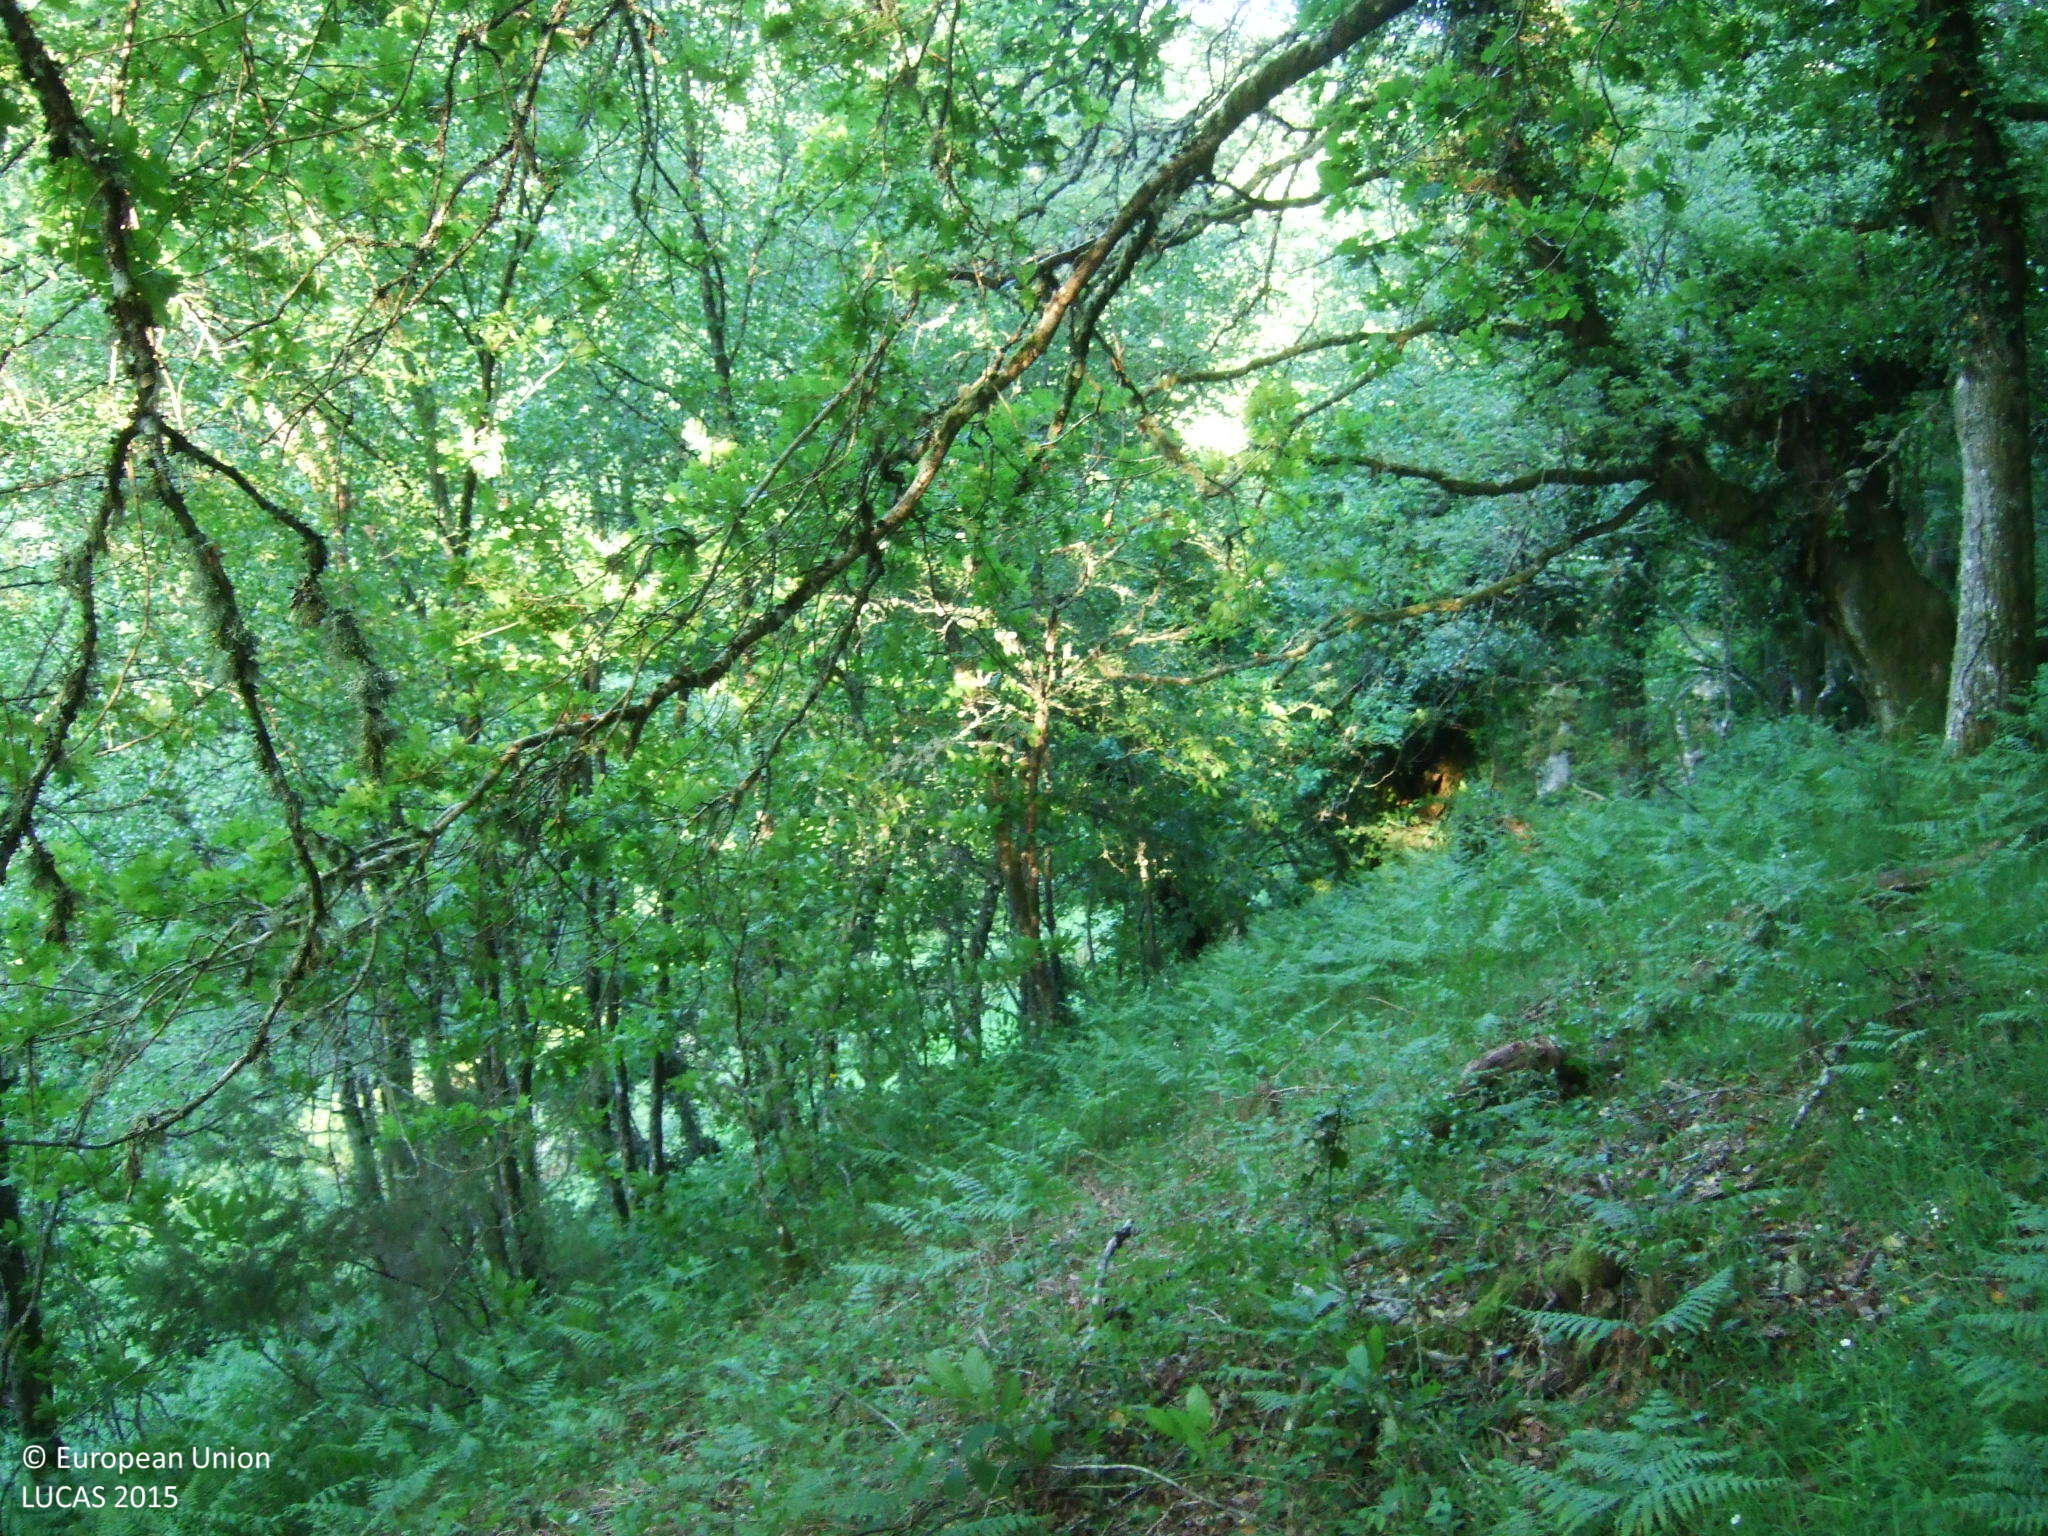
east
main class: Woodland
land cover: Broadleaved woodland
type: acidophilous oak and oak-birch forest
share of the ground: > 75 %
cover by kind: broadleaved forest trees 80 %, shrubs 20 %
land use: Forestry
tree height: > 5 m
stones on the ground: < 10 %
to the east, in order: Broadleaved woodland; Grassland without tree/shrub cover; Shrubland with sparse tree cover; Grassland without tree/shrub cover; Broadleaved woodland; Shrubland with sparse tree cover; Broadleaved woodland
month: May
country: ES
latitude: 42.7012
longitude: -7.2912
